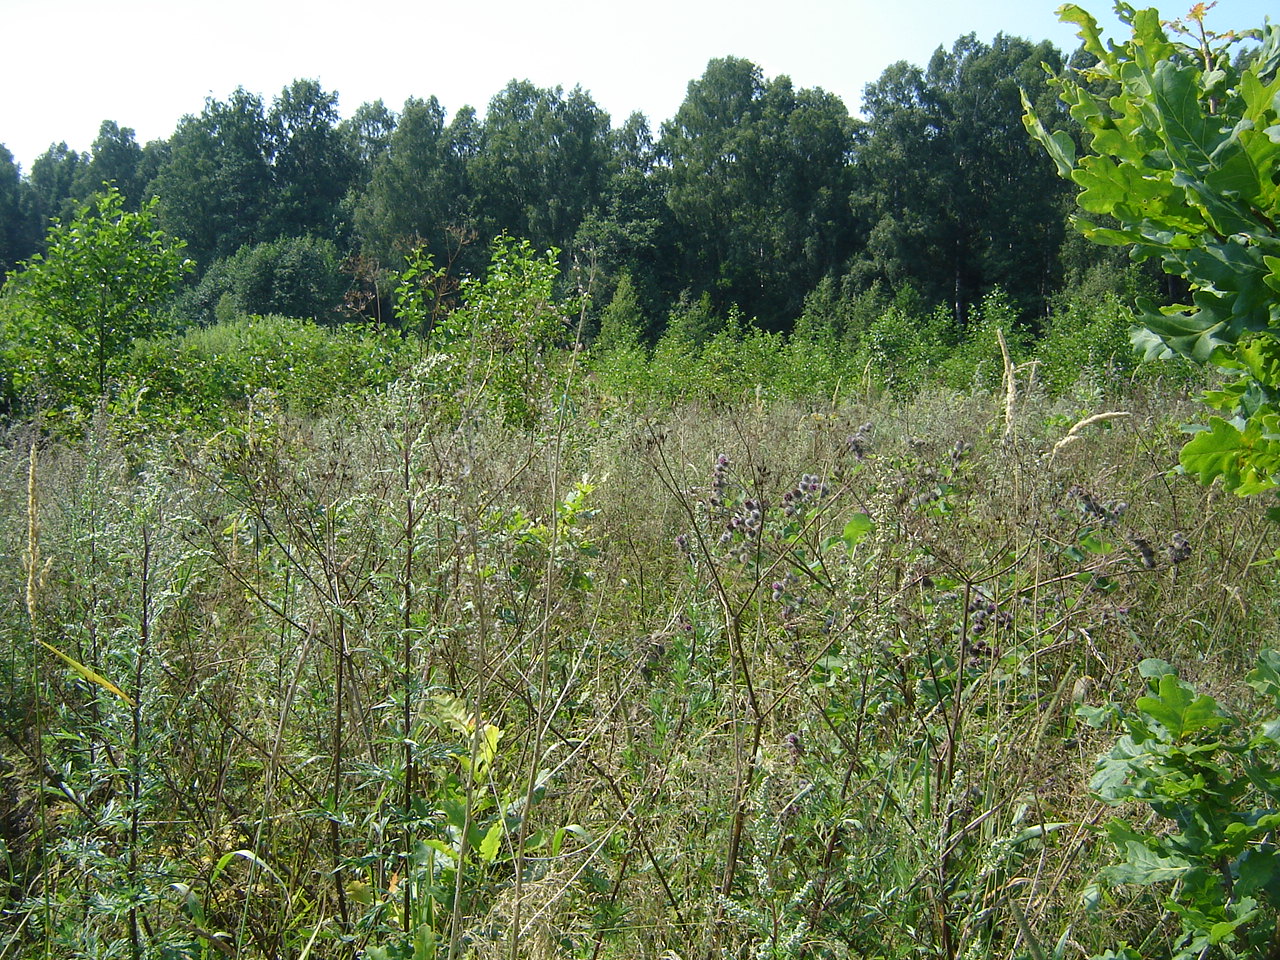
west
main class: Woodland
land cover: Broadleaved woodland
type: non-riverine alder, birch or aspen forest
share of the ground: 10 - 25 %
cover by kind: herbaceous plants 85 %, broadleaved forest trees 15 %
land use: Forestry
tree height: < 5 m
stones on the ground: < 10 %
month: August
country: LT
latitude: 55.1550
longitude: 25.4249
